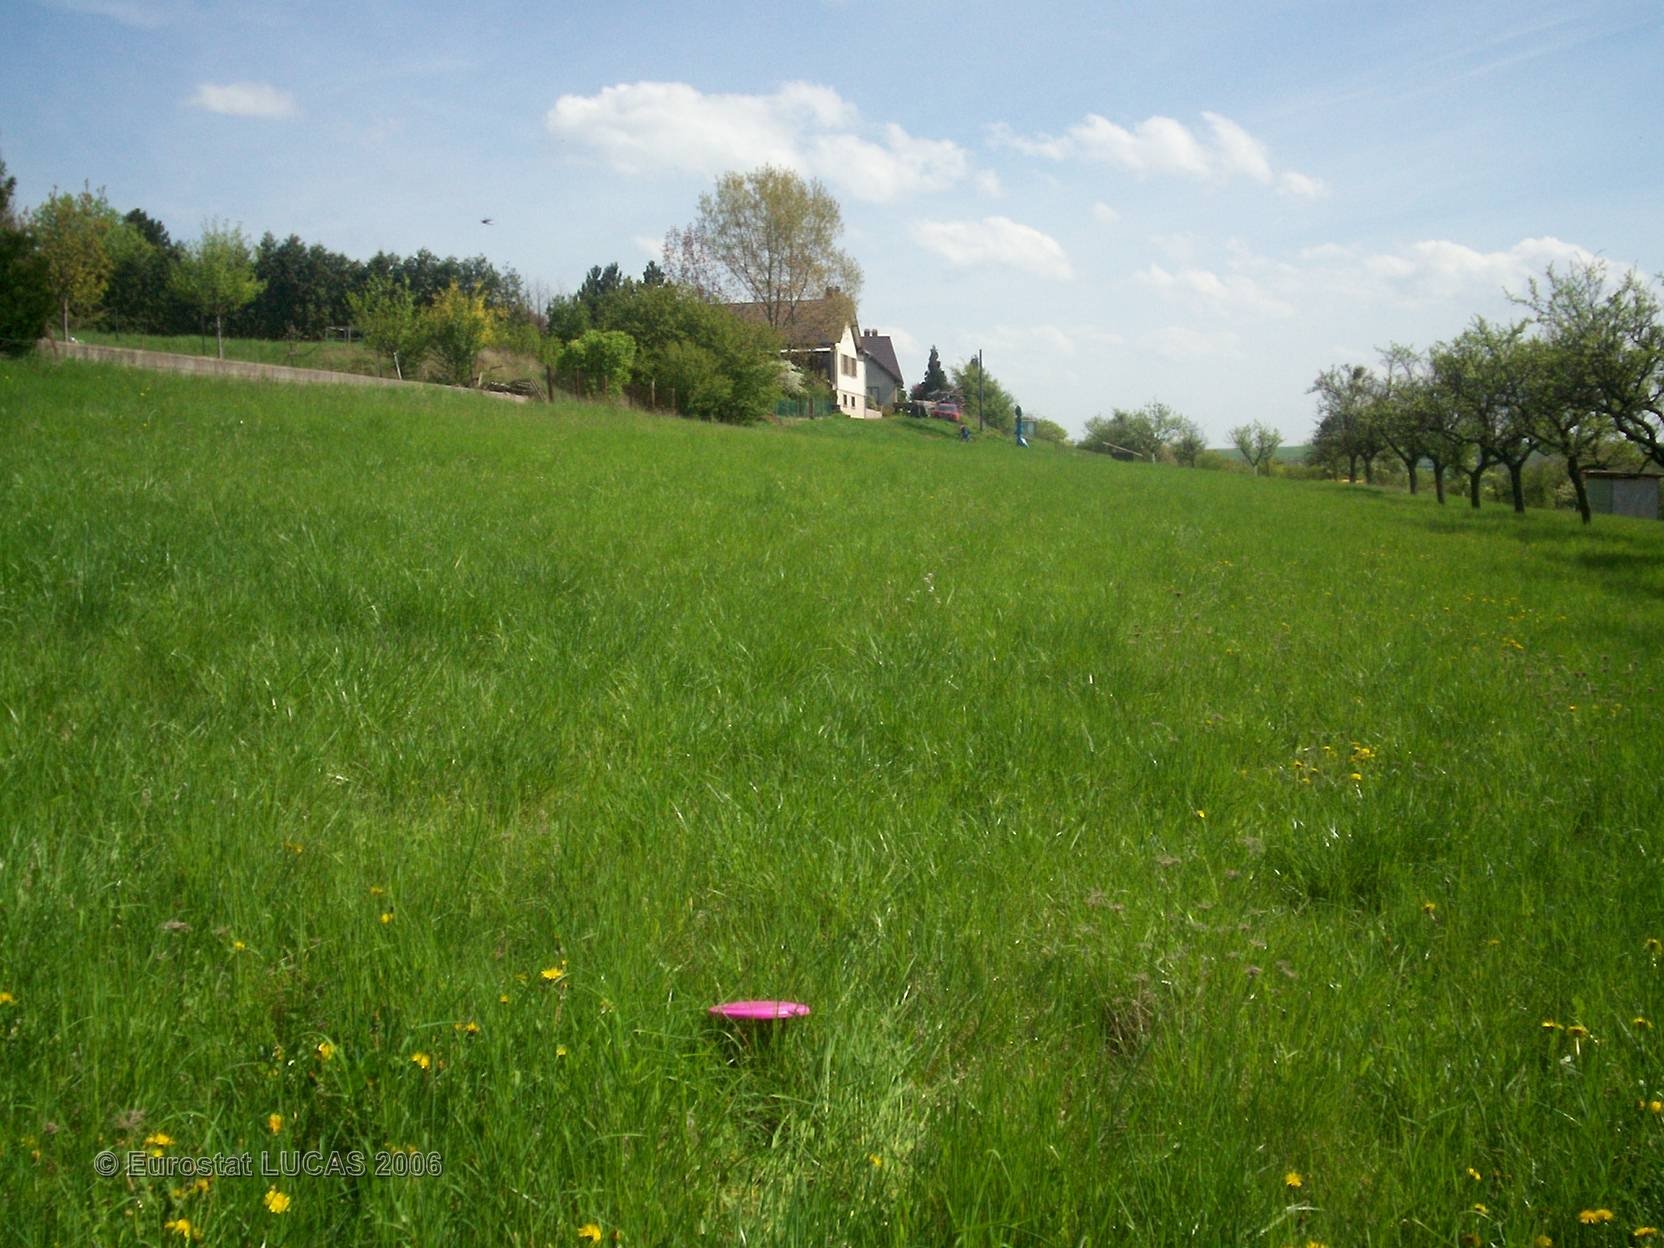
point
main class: Cropland
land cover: Other fruit trees and berries
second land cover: Grassland with sparse tree/shrub cover
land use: Agriculture (excluding fallow land and kitchen gardens)
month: May
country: FR
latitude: 49.0753
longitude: 6.7284
